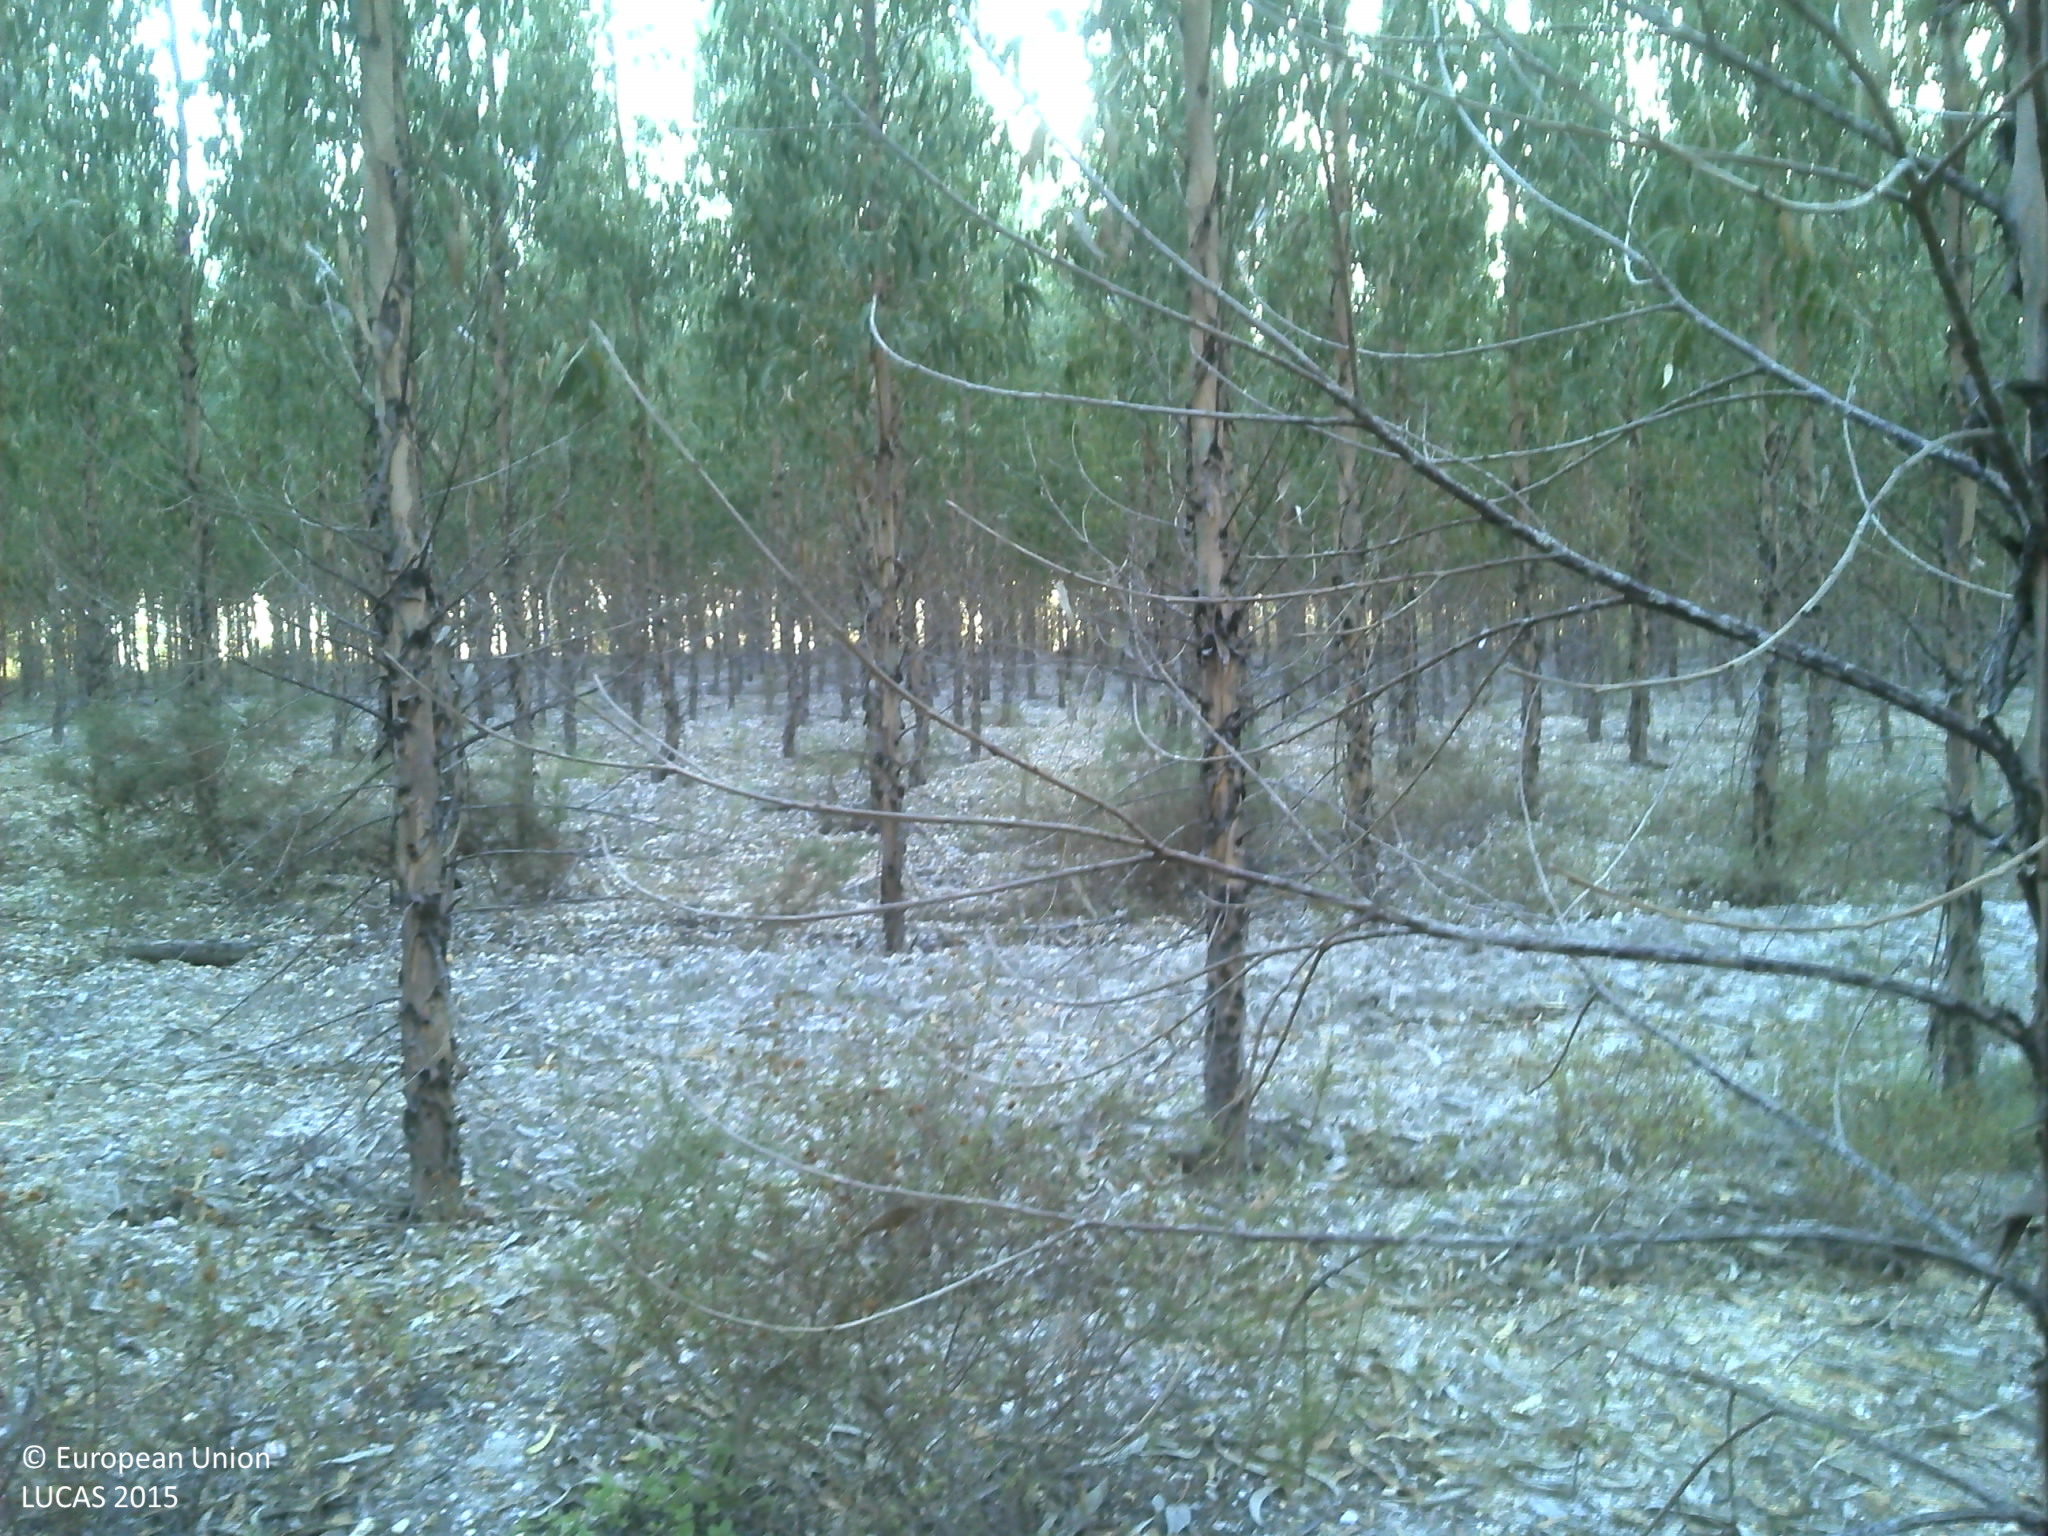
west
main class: Woodland
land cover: Broadleaved woodland
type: exotic forest
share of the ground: 50 - 75 %
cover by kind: broadleaved forest trees 60 %, unconsolidated bare surface 40 %
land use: Forestry
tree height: > 5 m
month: July
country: PT
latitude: 39.0076
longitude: -8.6002
